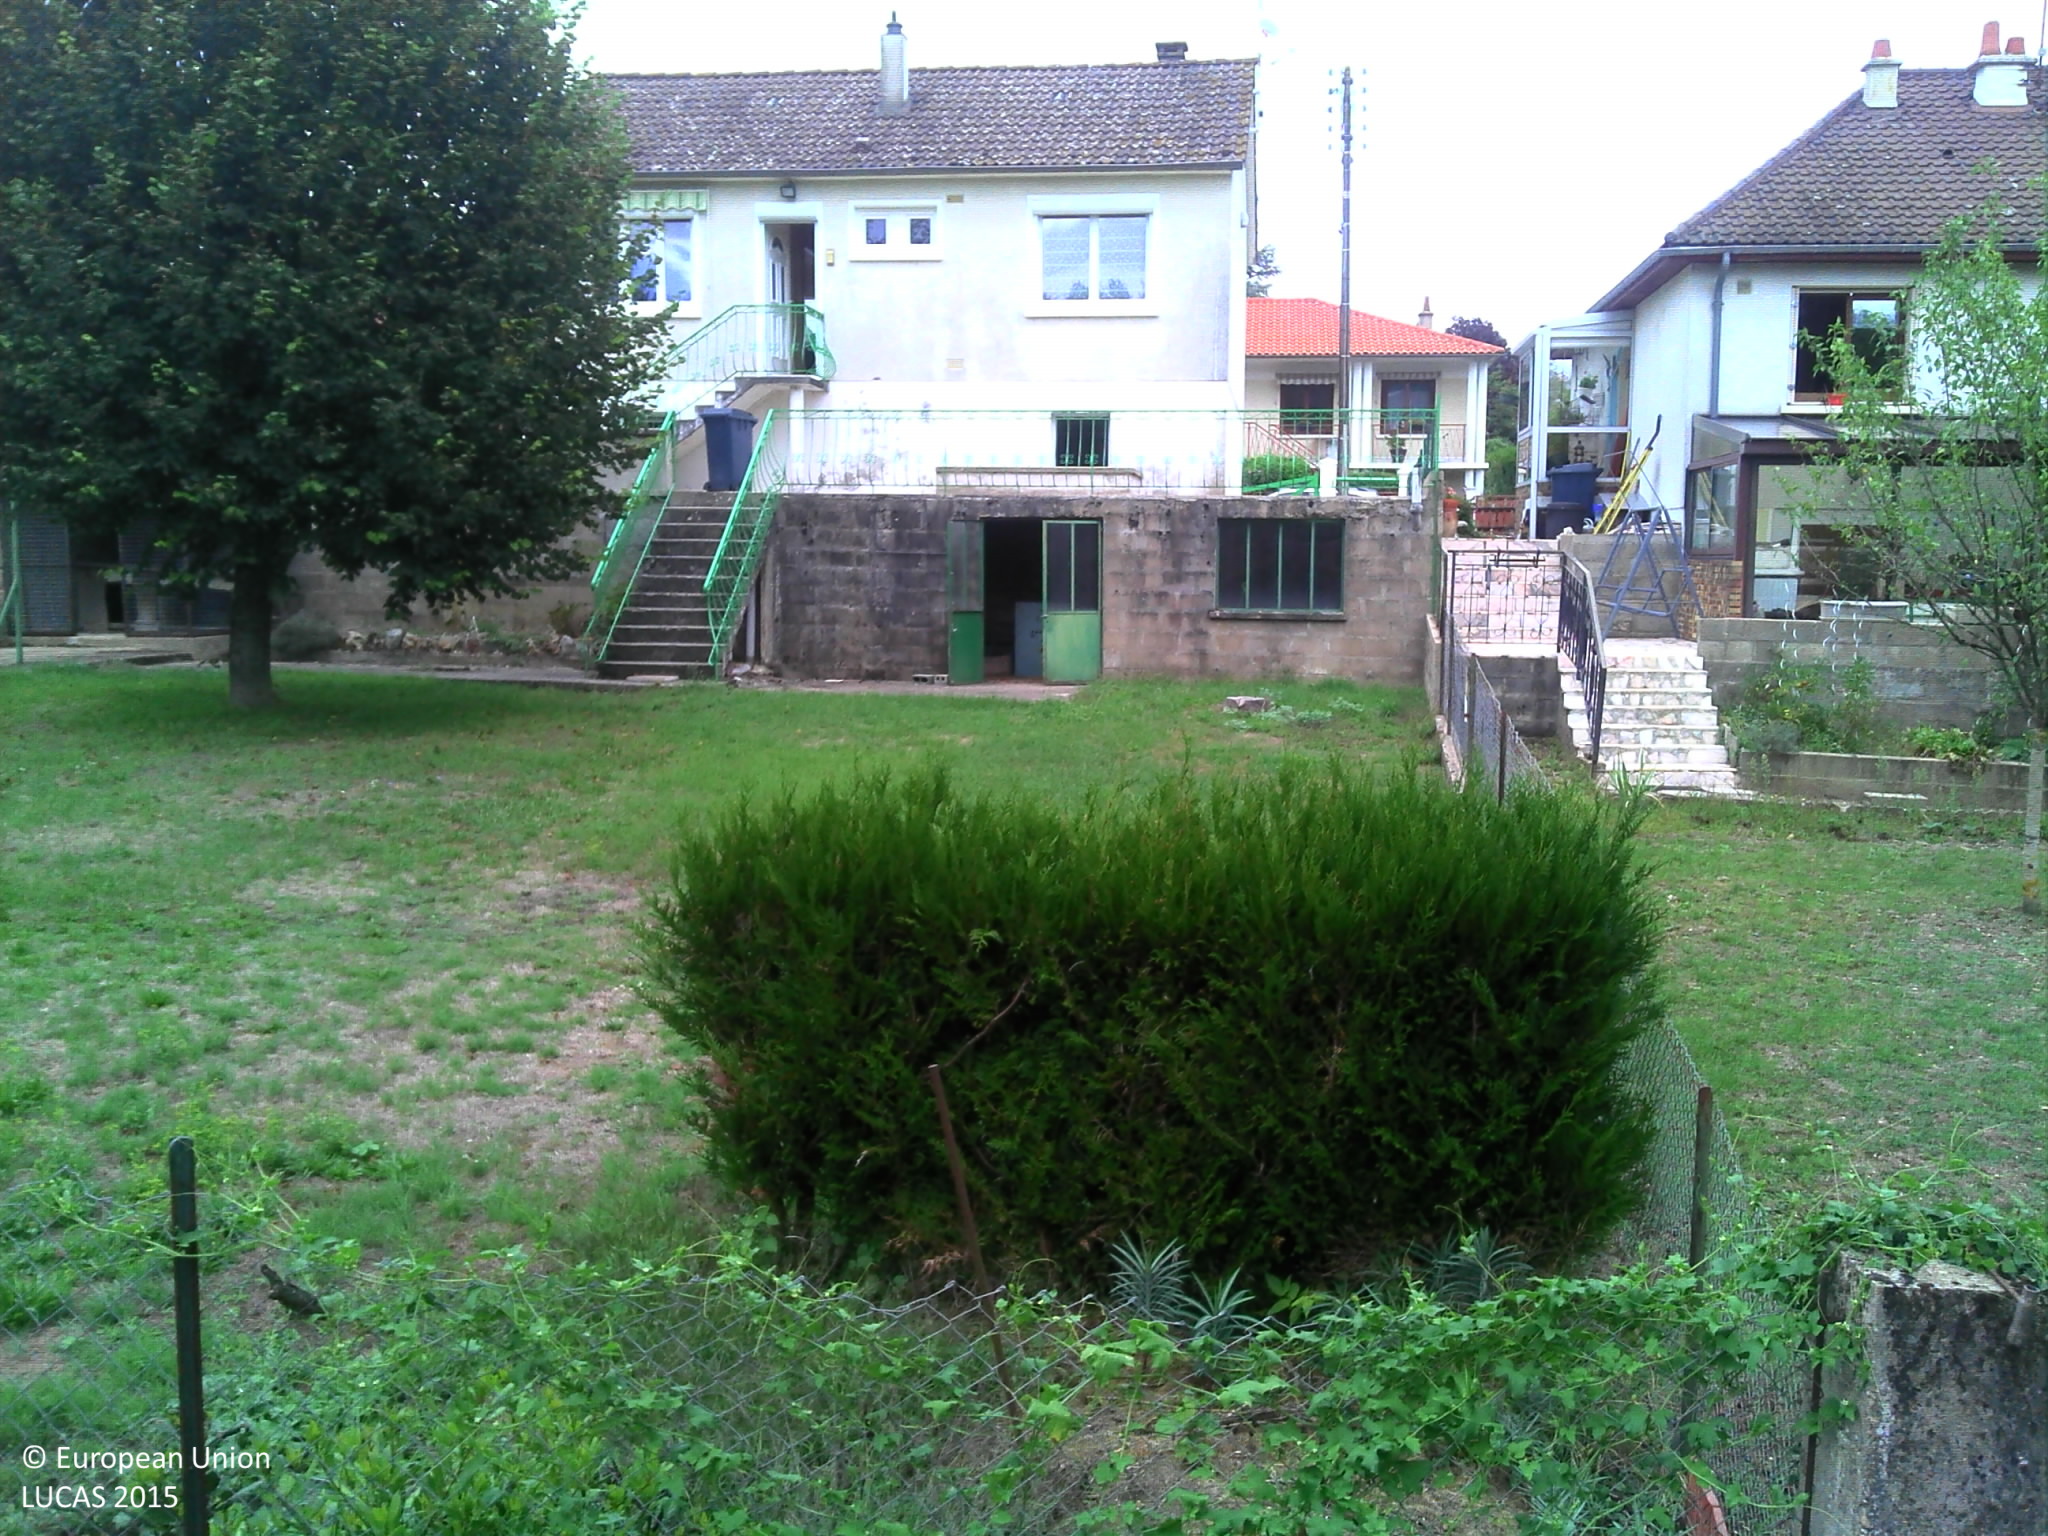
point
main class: Grassland
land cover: Grassland with sparse tree/shrub cover
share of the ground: > 75 %
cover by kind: herbaceous plants 55 %, unconsolidated bare surface 40 %, broadleaved forest trees 5 %
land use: Residential
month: September
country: FR
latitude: 46.8476
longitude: 1.5301
